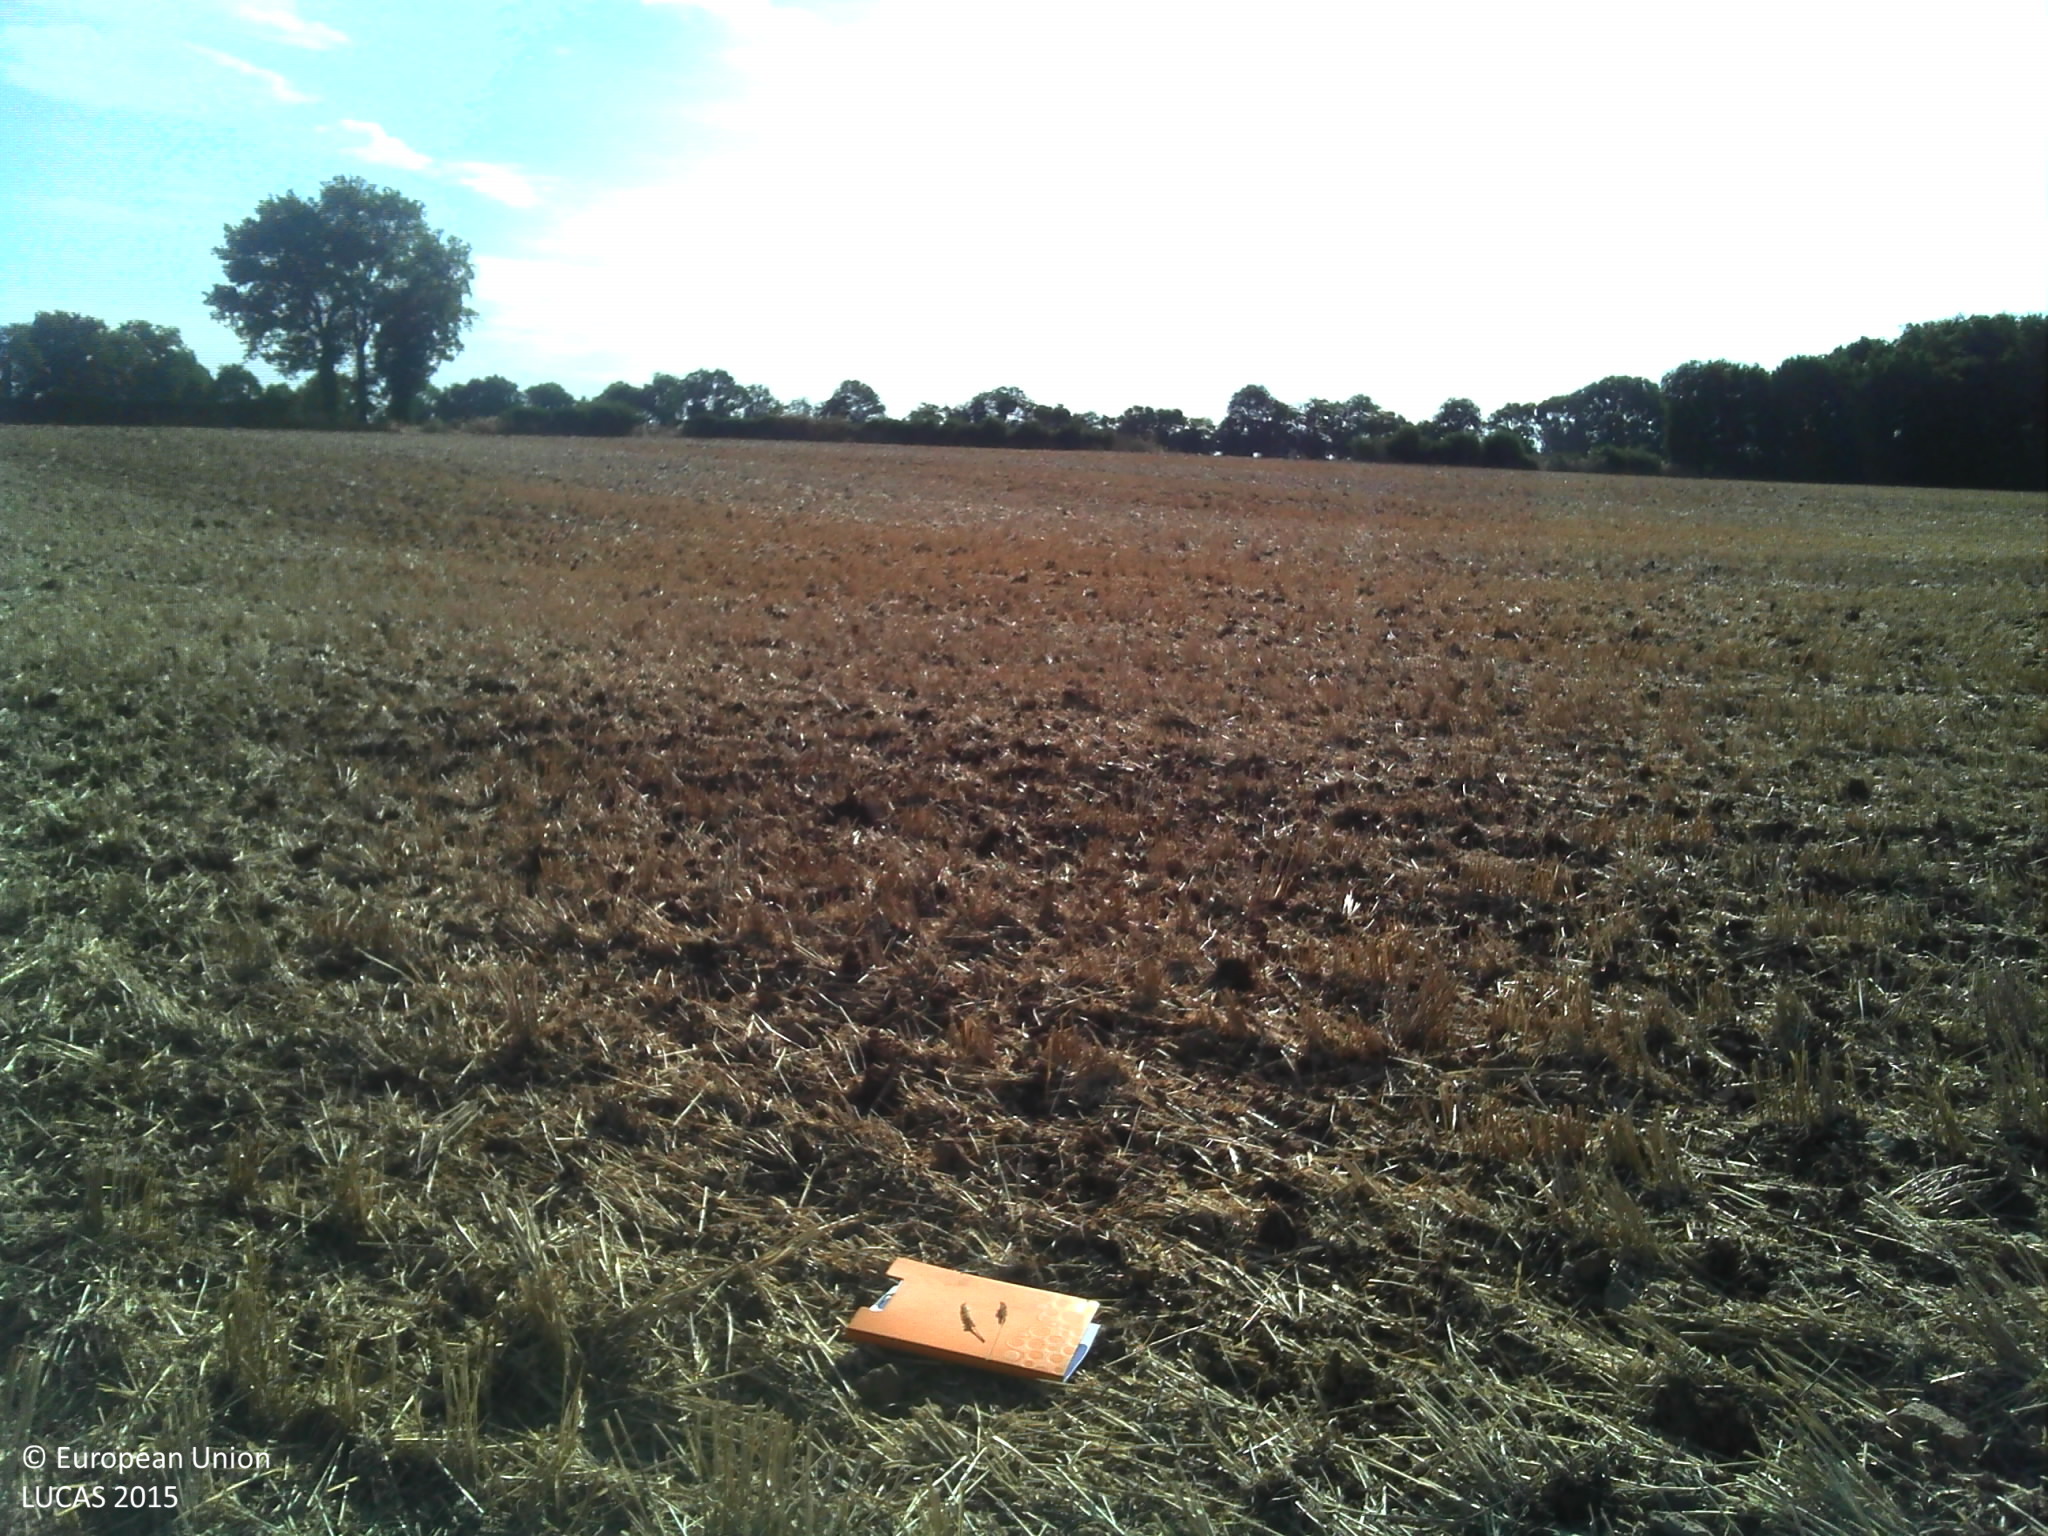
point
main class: Cropland
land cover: Common wheat
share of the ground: > 75 %
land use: Agriculture (excluding fallow land and kitchen gardens)
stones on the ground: 10 - 25 %
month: July
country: FR
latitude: 46.5908
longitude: 2.2013
